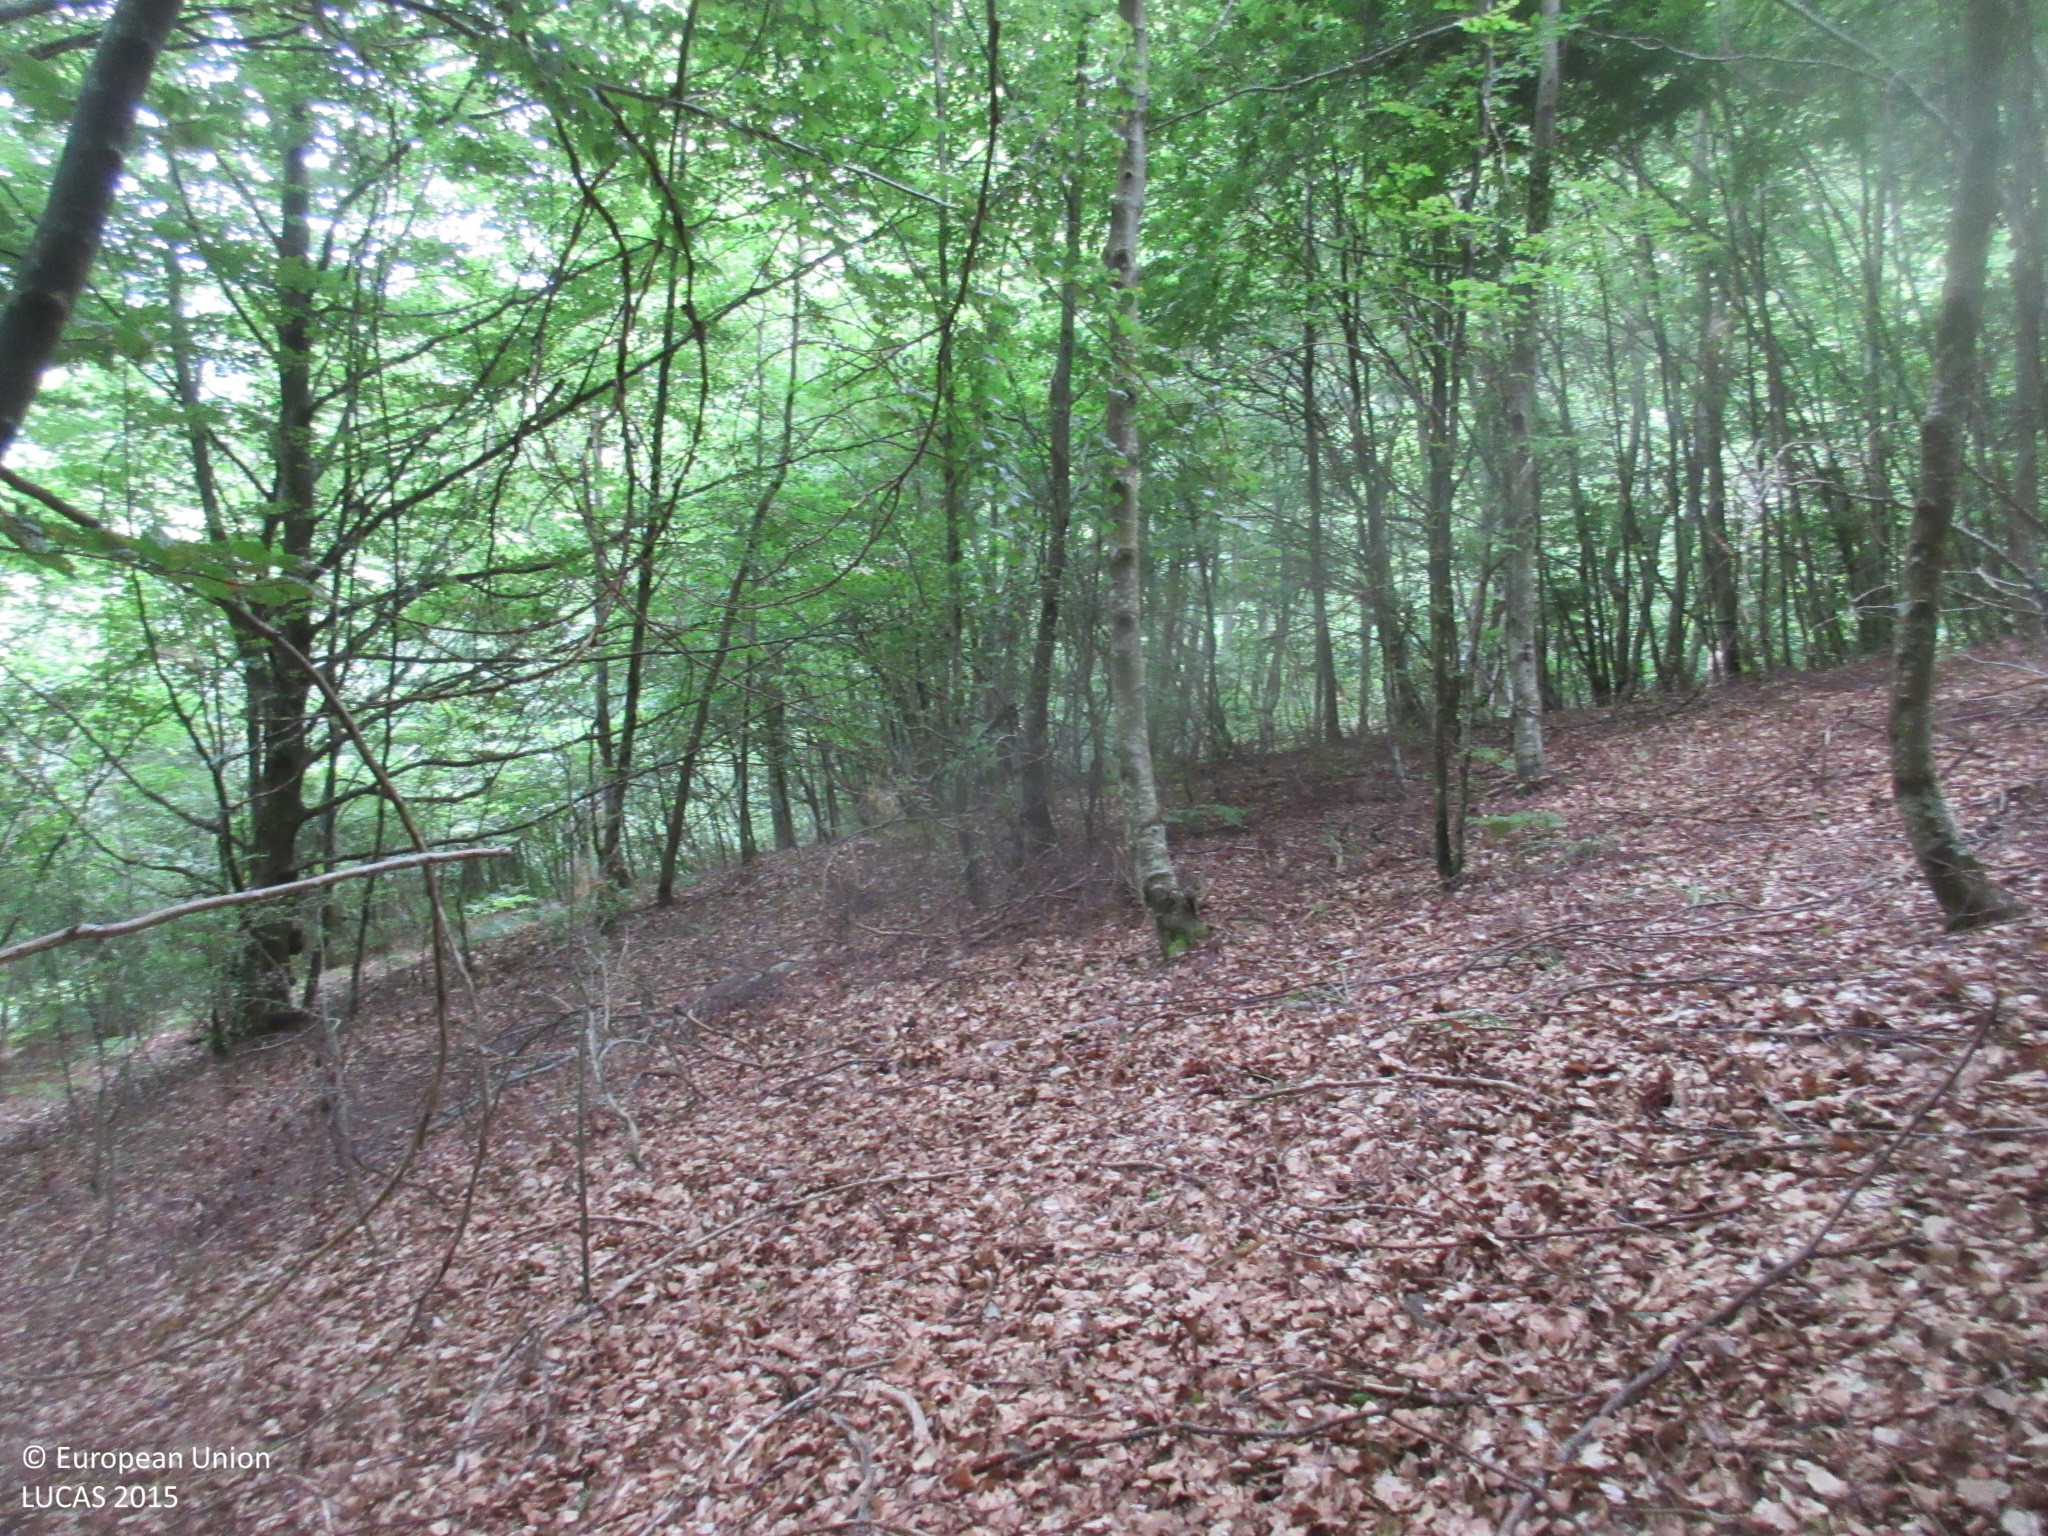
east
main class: Woodland
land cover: Broadleaved woodland
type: beech forest
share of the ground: > 75 %
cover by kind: broadleaved forest trees 100 %
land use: Semi-natural and natural areas not in use
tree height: > 5 m
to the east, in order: Broadleaved woodland; Rivers and streams; Broadleaved woodland
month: June
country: ES
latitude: 43.0678
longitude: -4.5112
